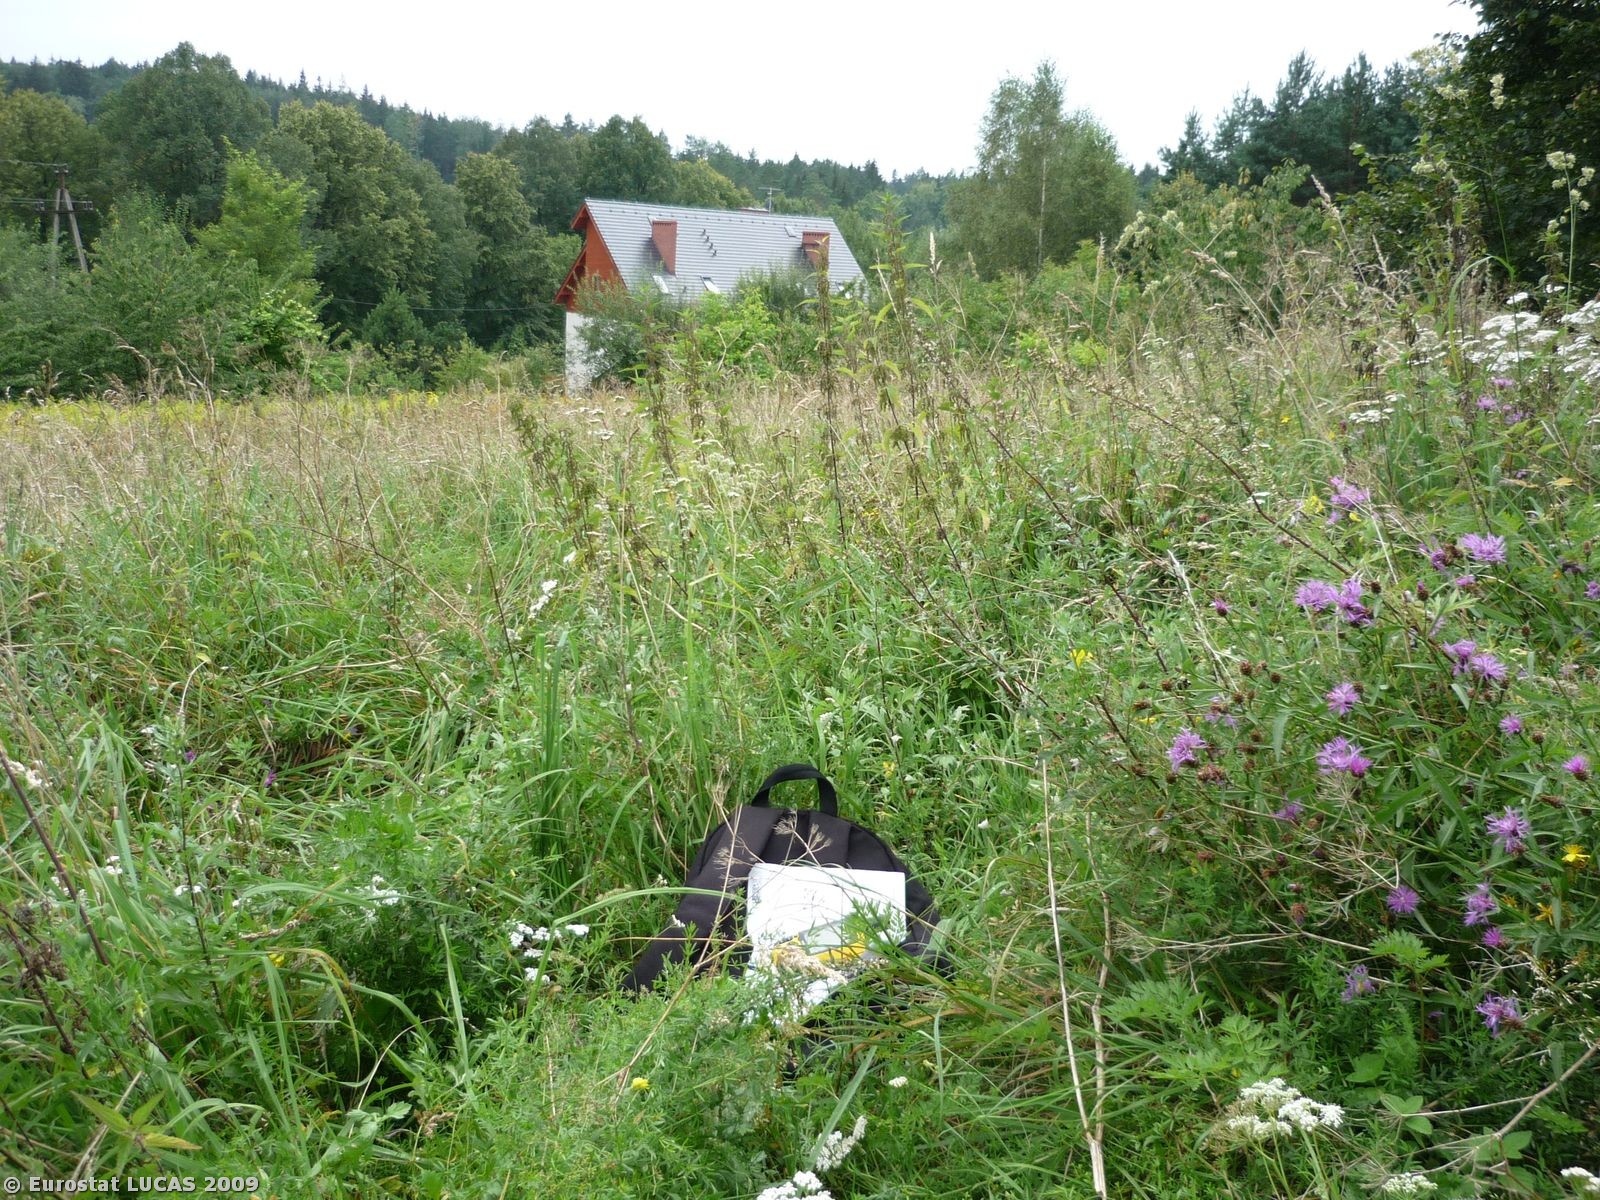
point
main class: Grassland
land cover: Grassland with sparse tree/shrub cover
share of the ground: > 75 %
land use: Nature reserves
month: August
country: PL
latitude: 50.9952
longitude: 16.0902
